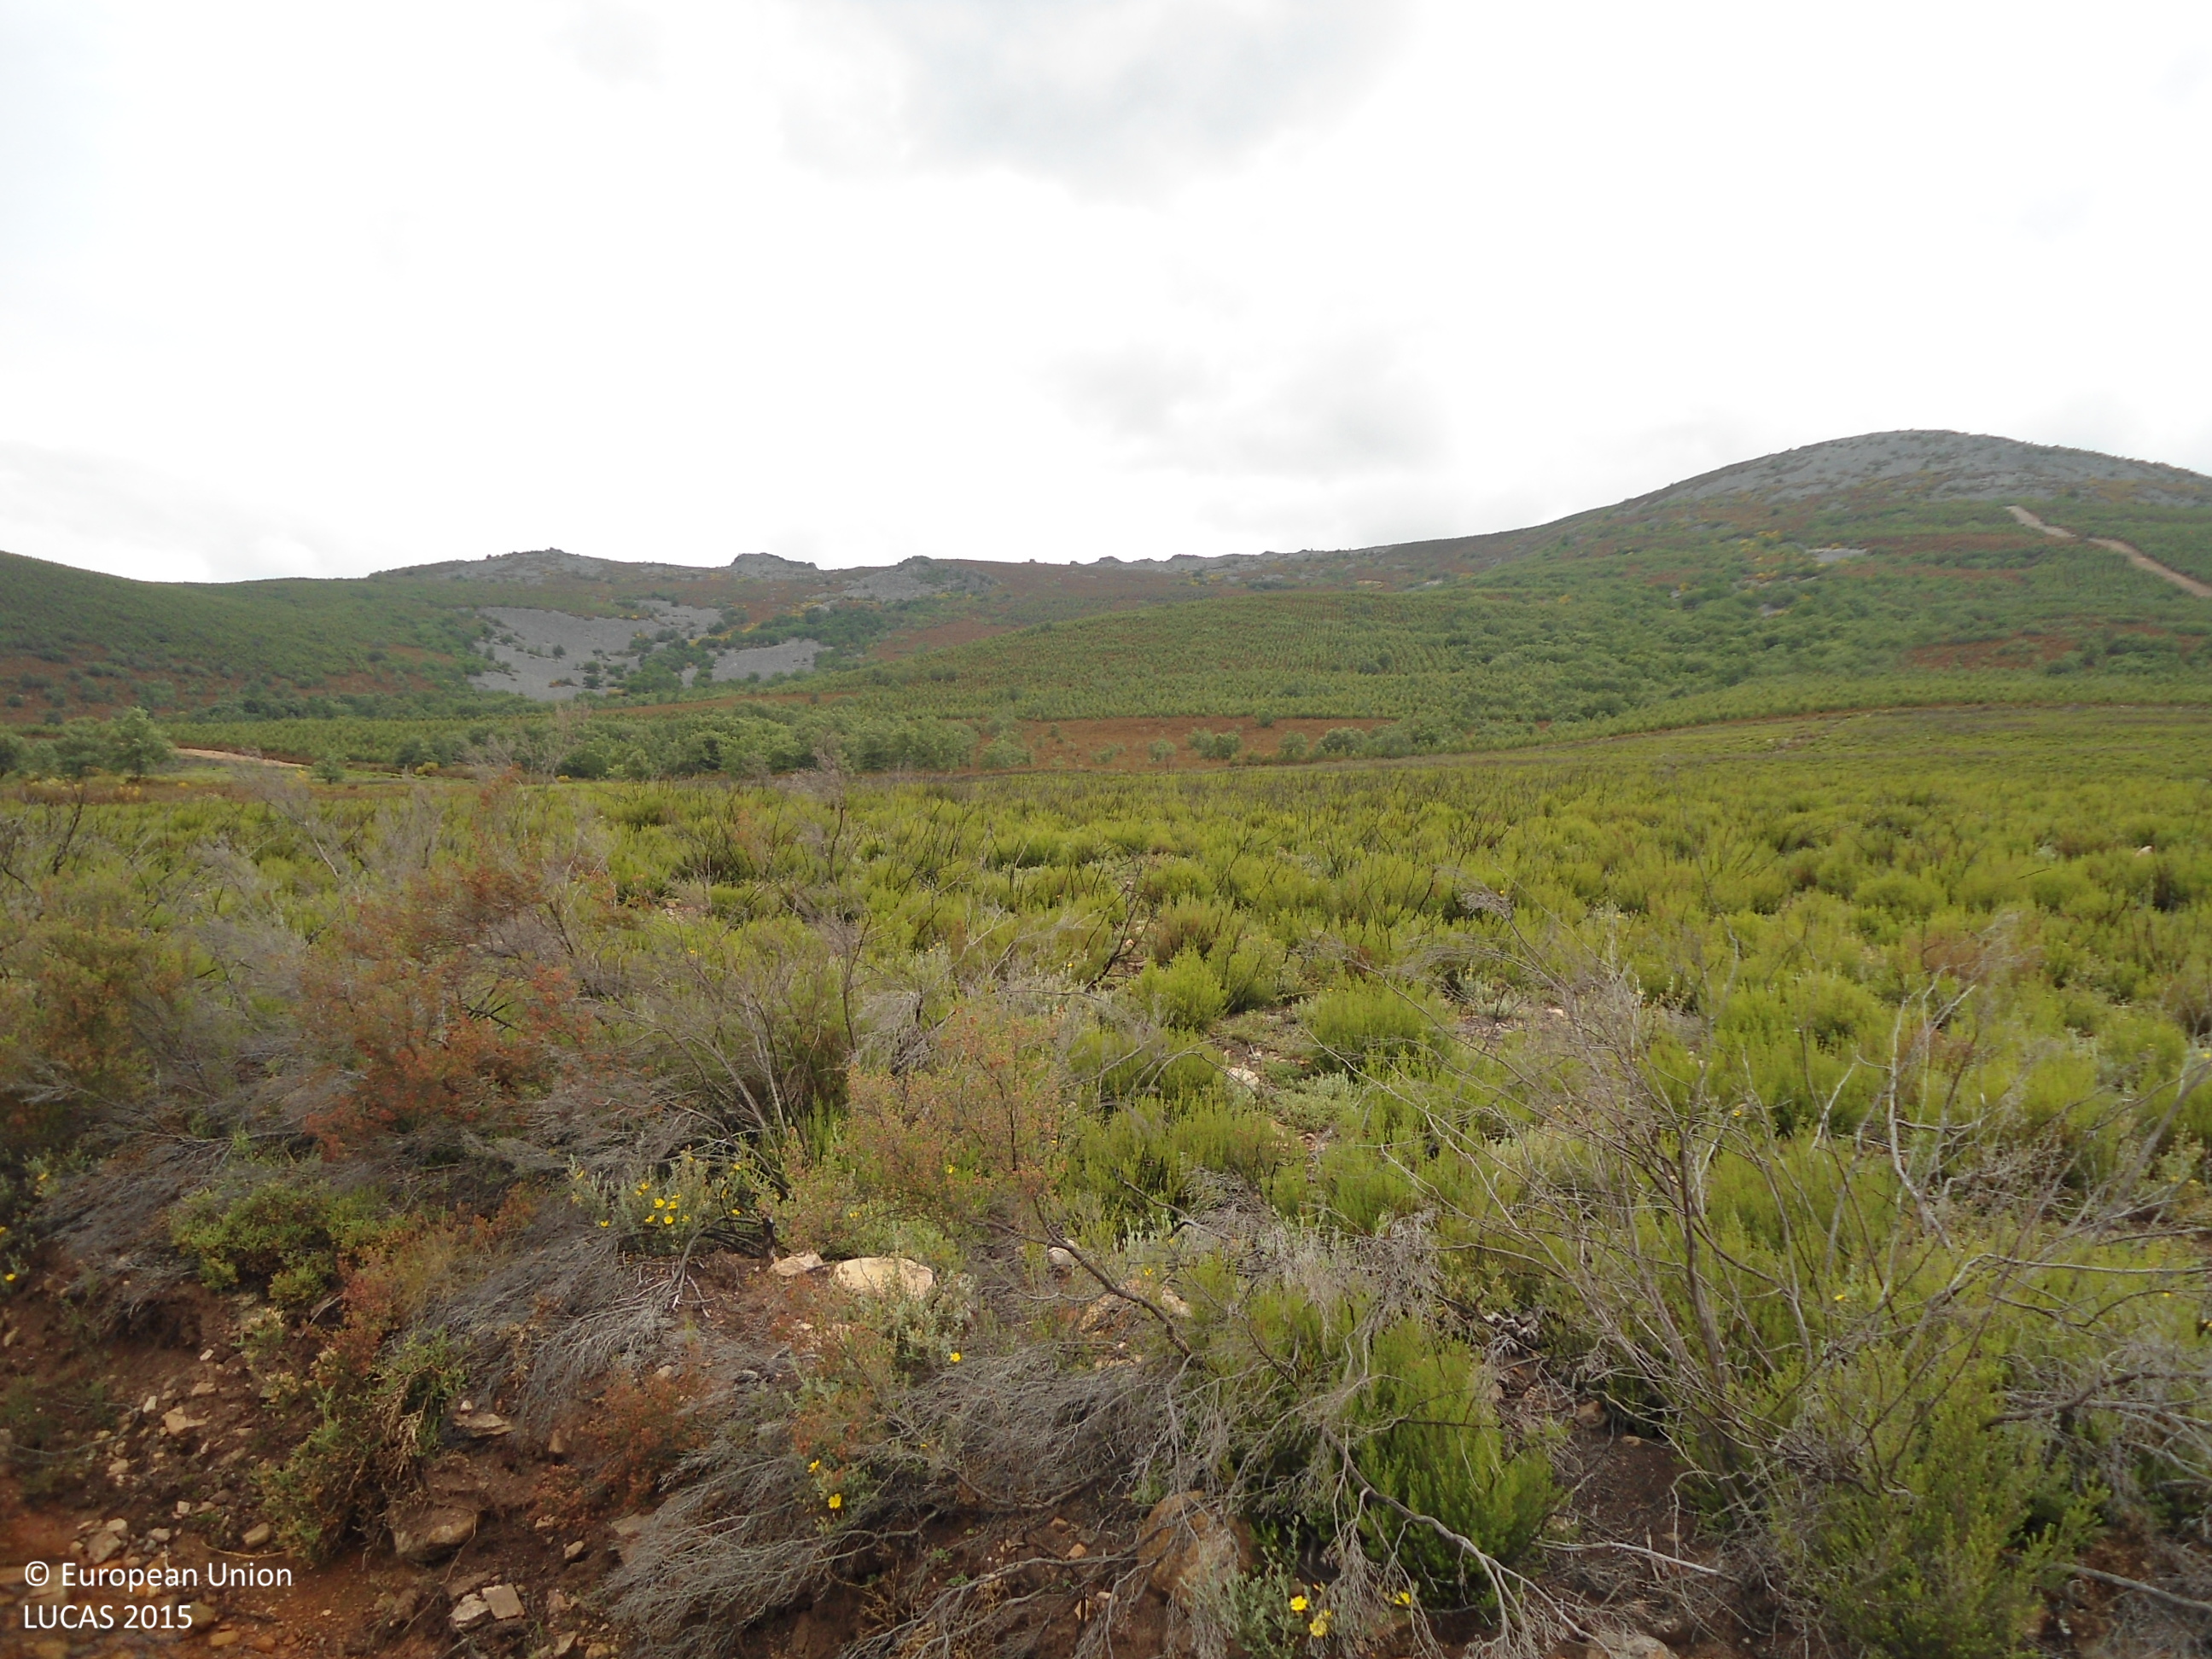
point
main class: Woodland
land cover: Broadleaved woodland
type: floodplain forest
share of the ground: > 75 %
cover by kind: broadleaved forest trees 90 %, shrubs 10 %
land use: Semi-natural and natural areas not in use
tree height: > 5 m
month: June
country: ES
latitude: 42.2114
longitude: -6.3776
